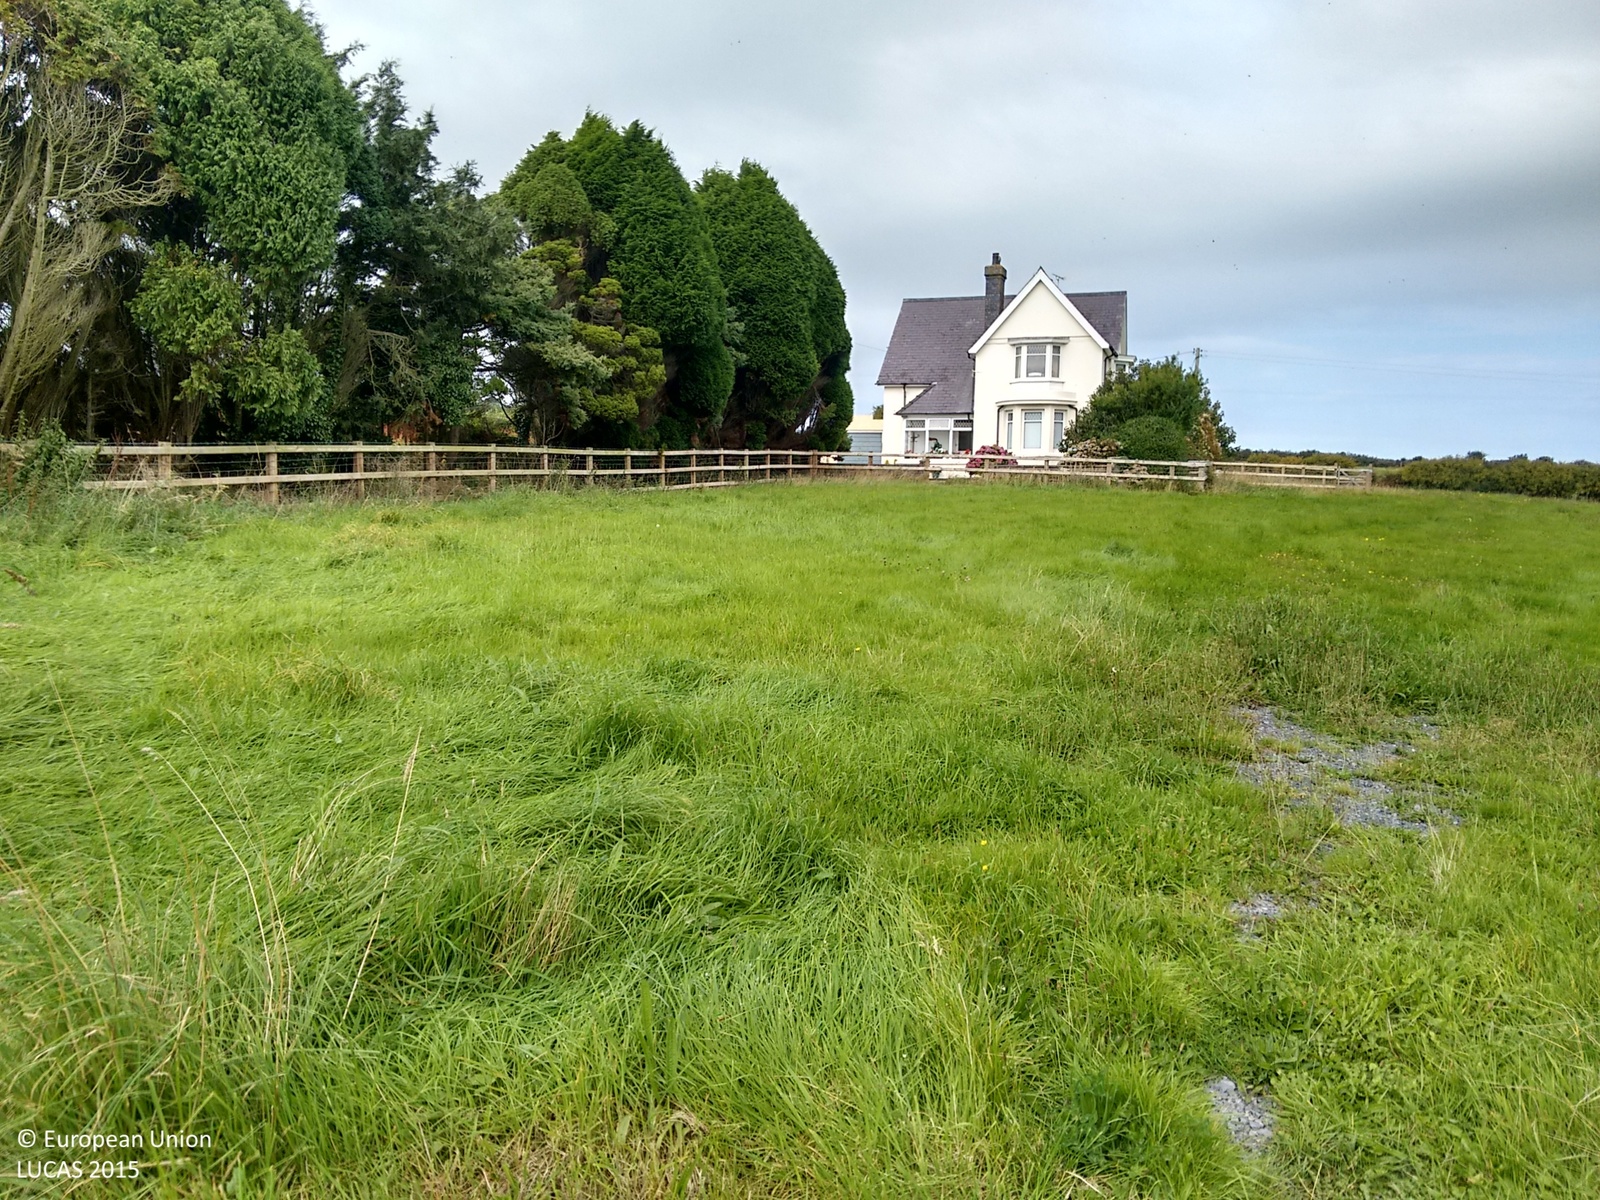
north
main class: Grassland
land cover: Grassland without tree/shrub cover
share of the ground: > 75 %
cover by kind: herbaceous plants 100 %
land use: Agriculture (excluding fallow land and kitchen gardens)
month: September
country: GB
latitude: 52.1108
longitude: -4.5778
